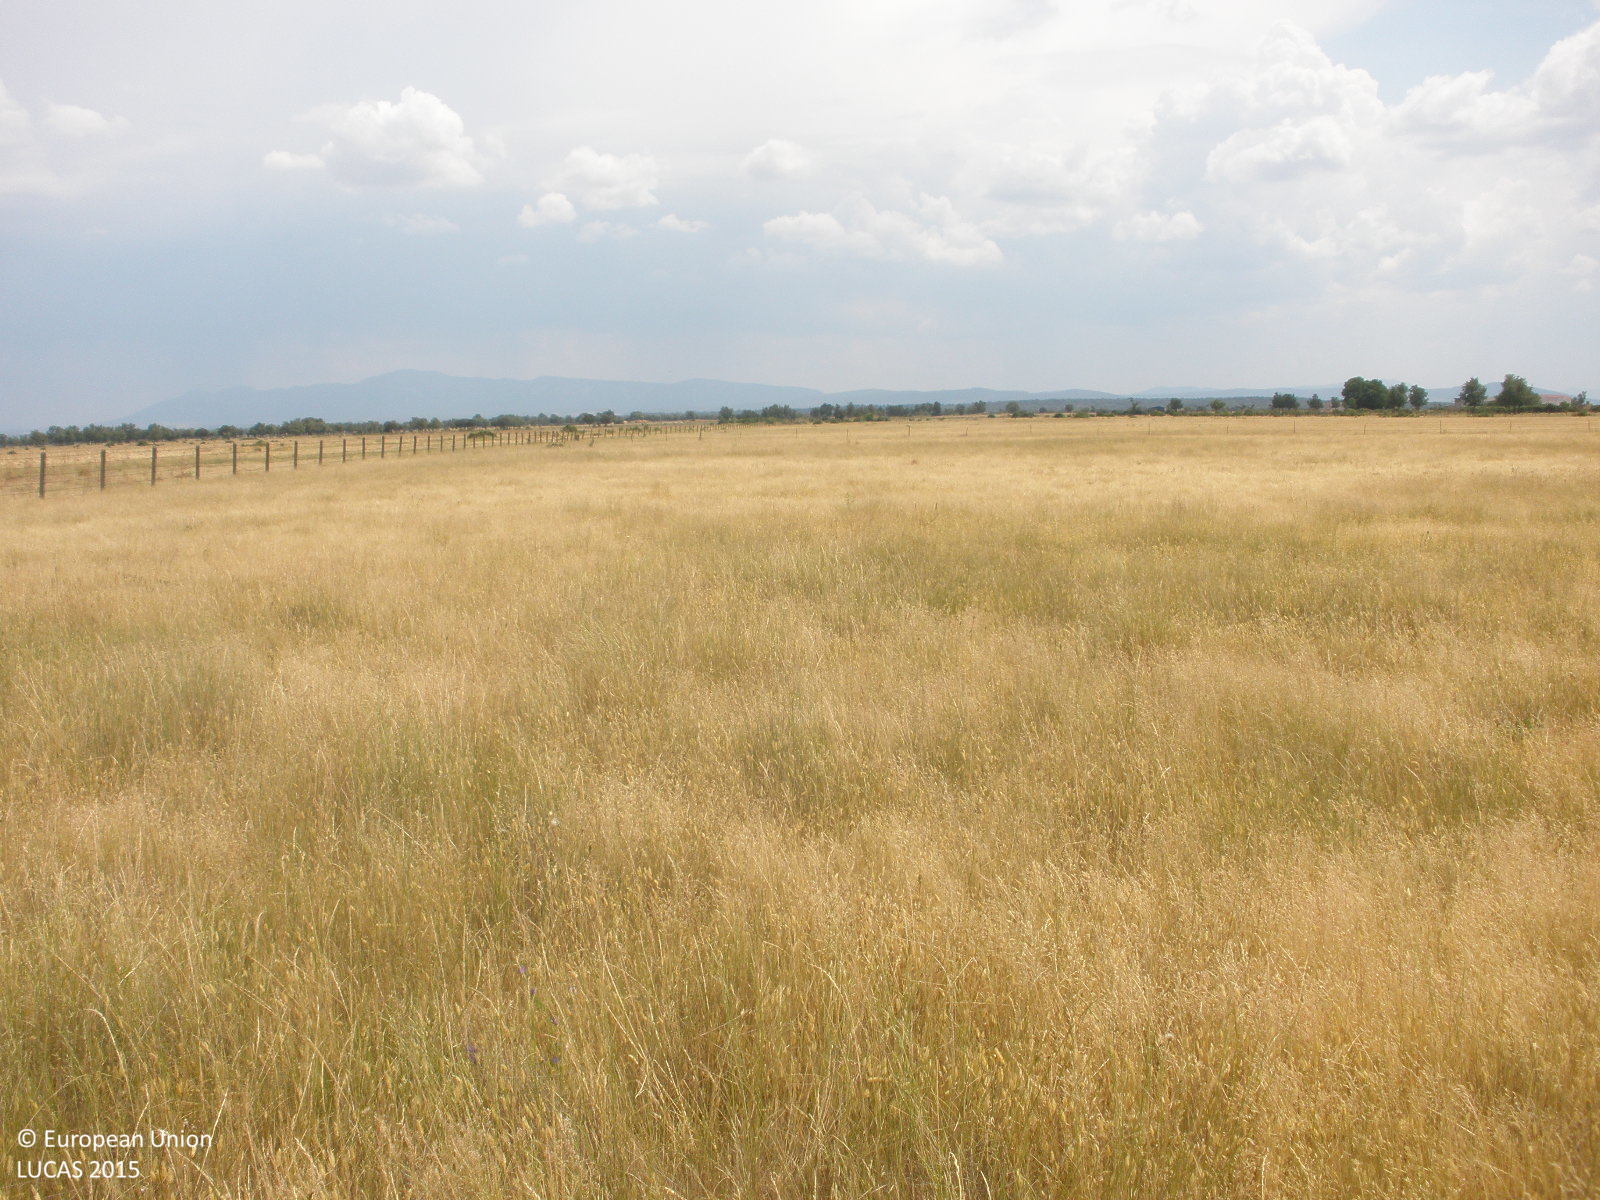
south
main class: Grassland
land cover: Grassland without tree/shrub cover
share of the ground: > 75 %
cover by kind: herbaceous plants 100 %
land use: Agriculture (excluding fallow land and kitchen gardens)
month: June
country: ES
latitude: 40.7019
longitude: -6.3854
